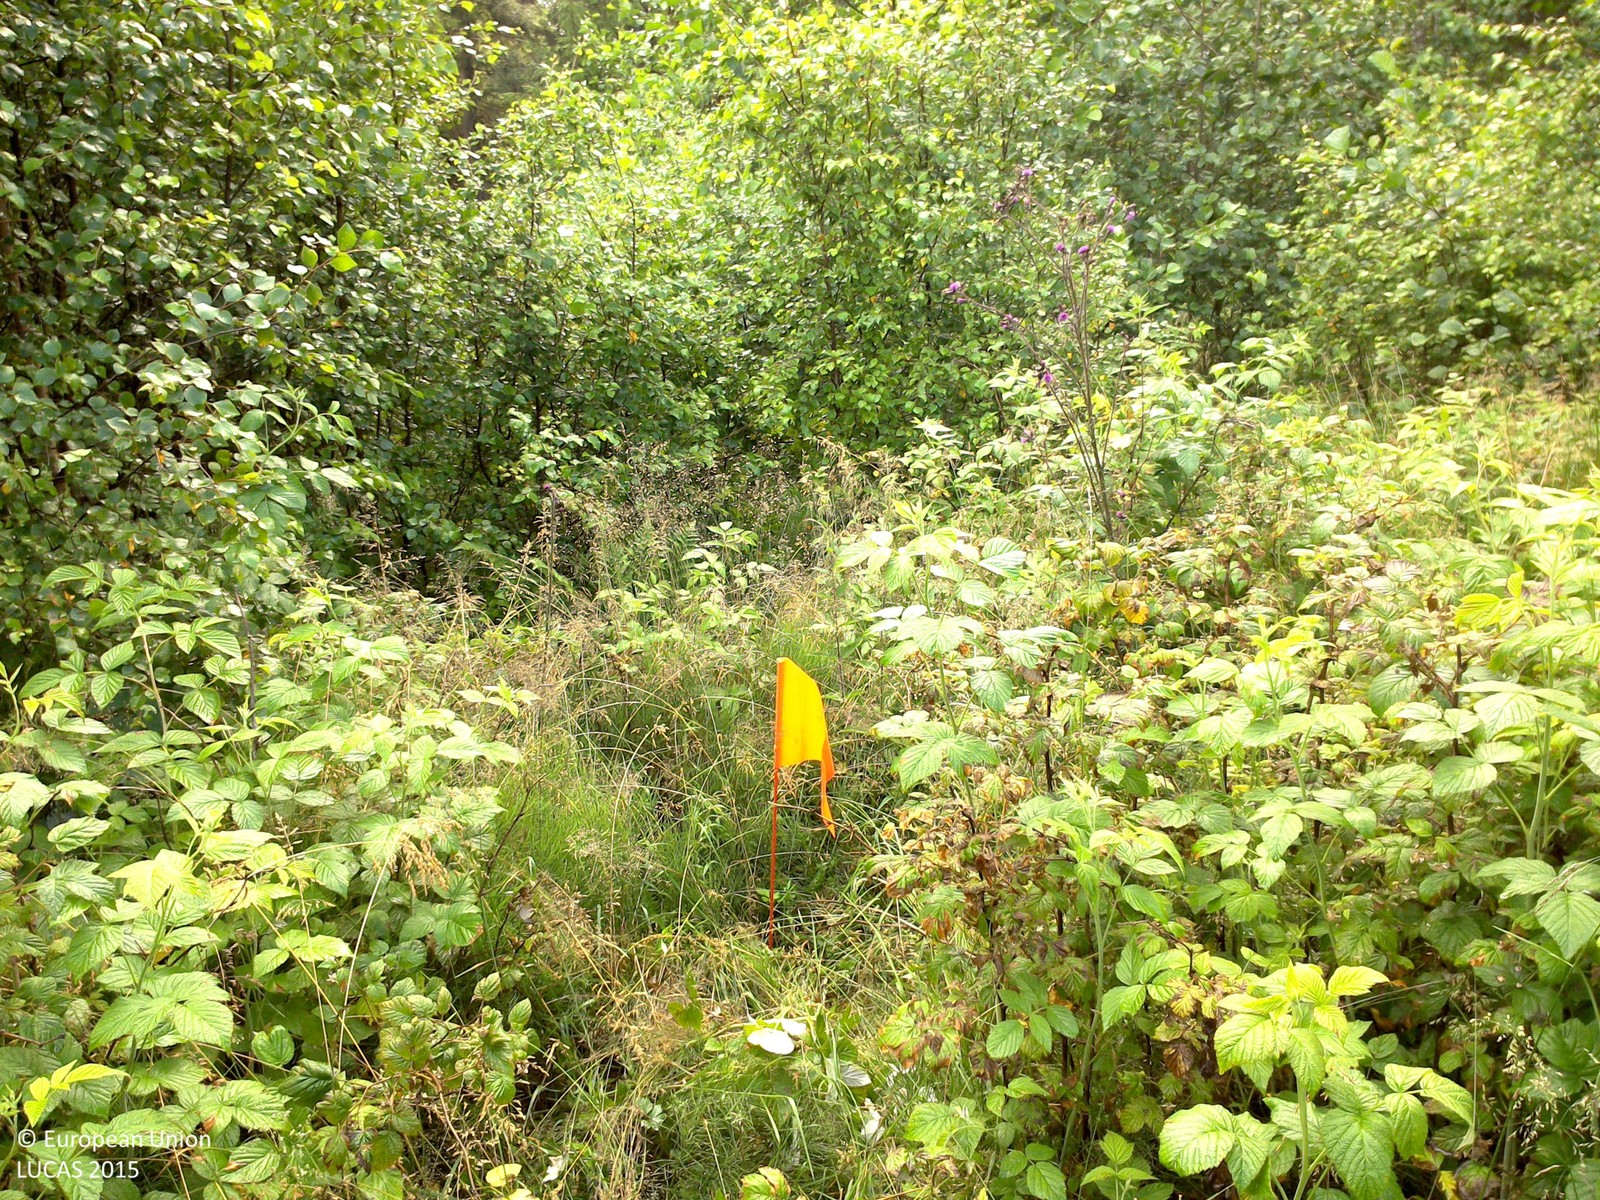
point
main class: Woodland
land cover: Broadleaved woodland
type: boreal forest
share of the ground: > 75 %
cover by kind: broadleaved forest trees 80 %, shrubs 10 %, herbaceous plants 10 %
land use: Forestry
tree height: < 5 m
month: July
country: SE
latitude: 57.9508
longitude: 14.8779
